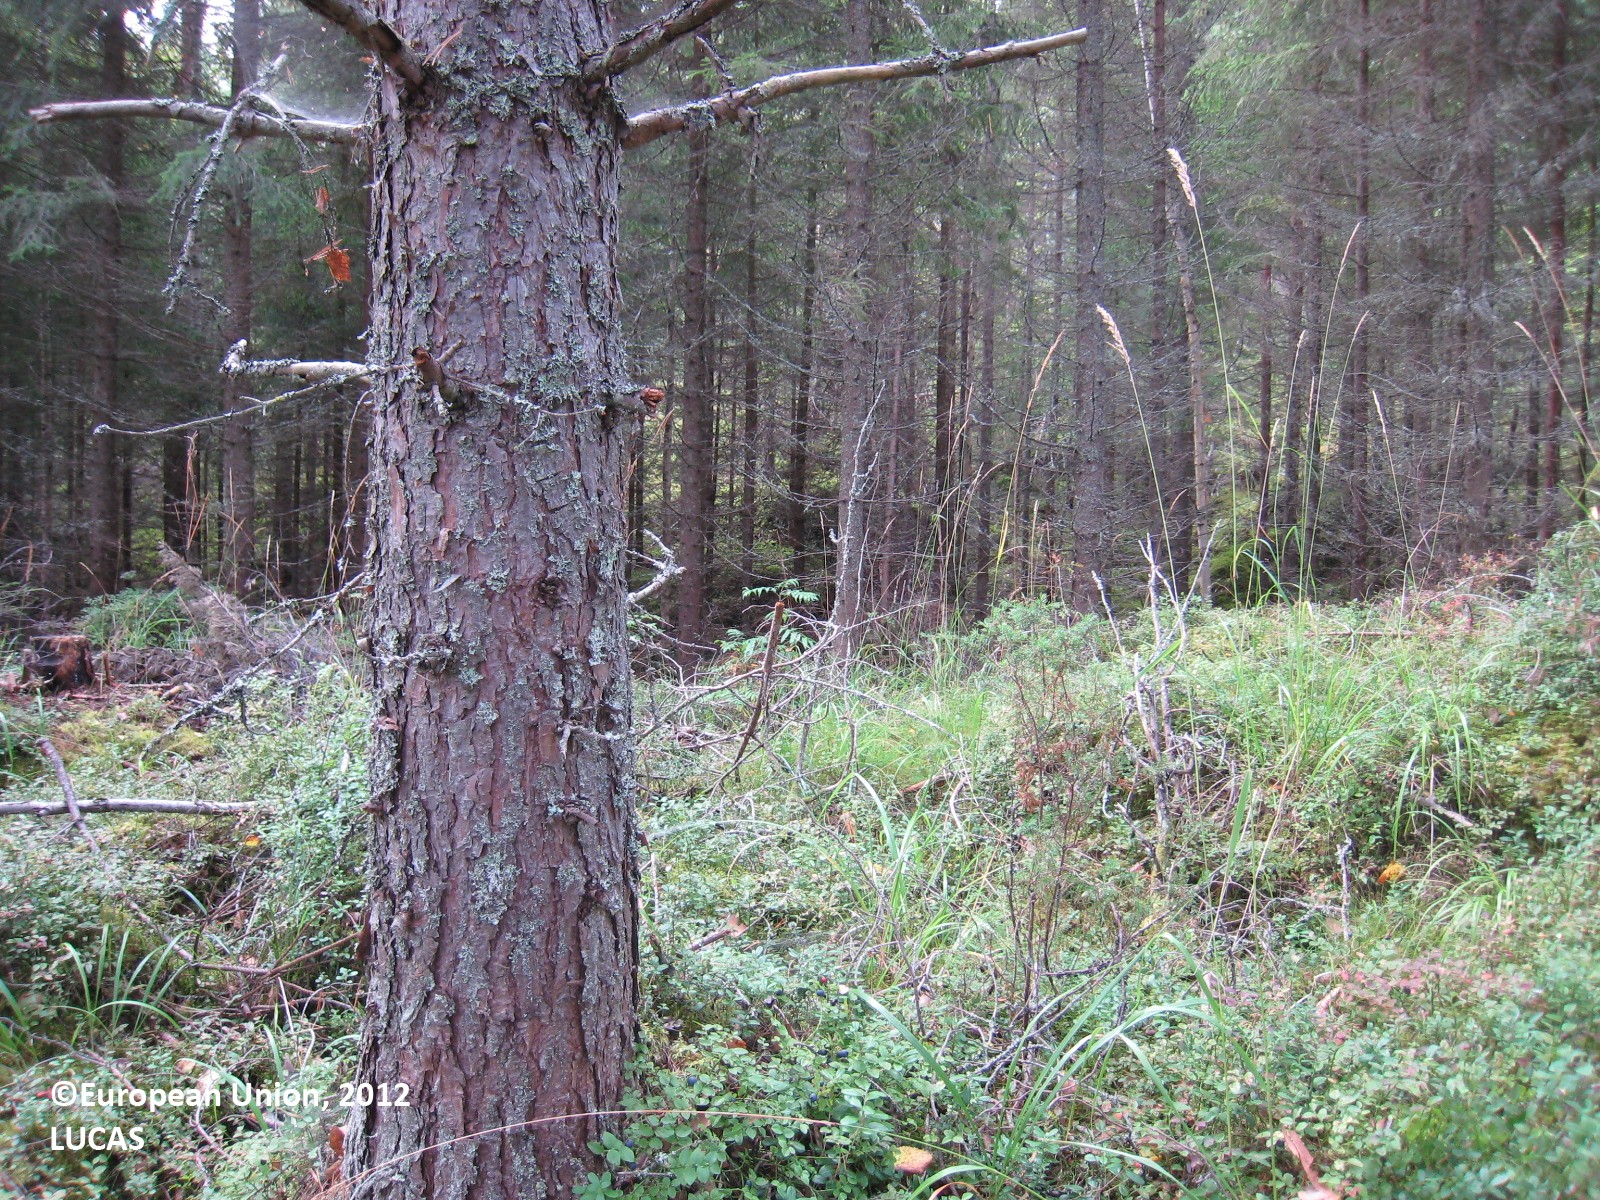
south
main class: Woodland
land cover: Pine dominated coniferous woodland
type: boreal forest
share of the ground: > 75 %
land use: Forestry
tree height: > 5 m
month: August
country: FI
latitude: 62.1372
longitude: 27.2924
